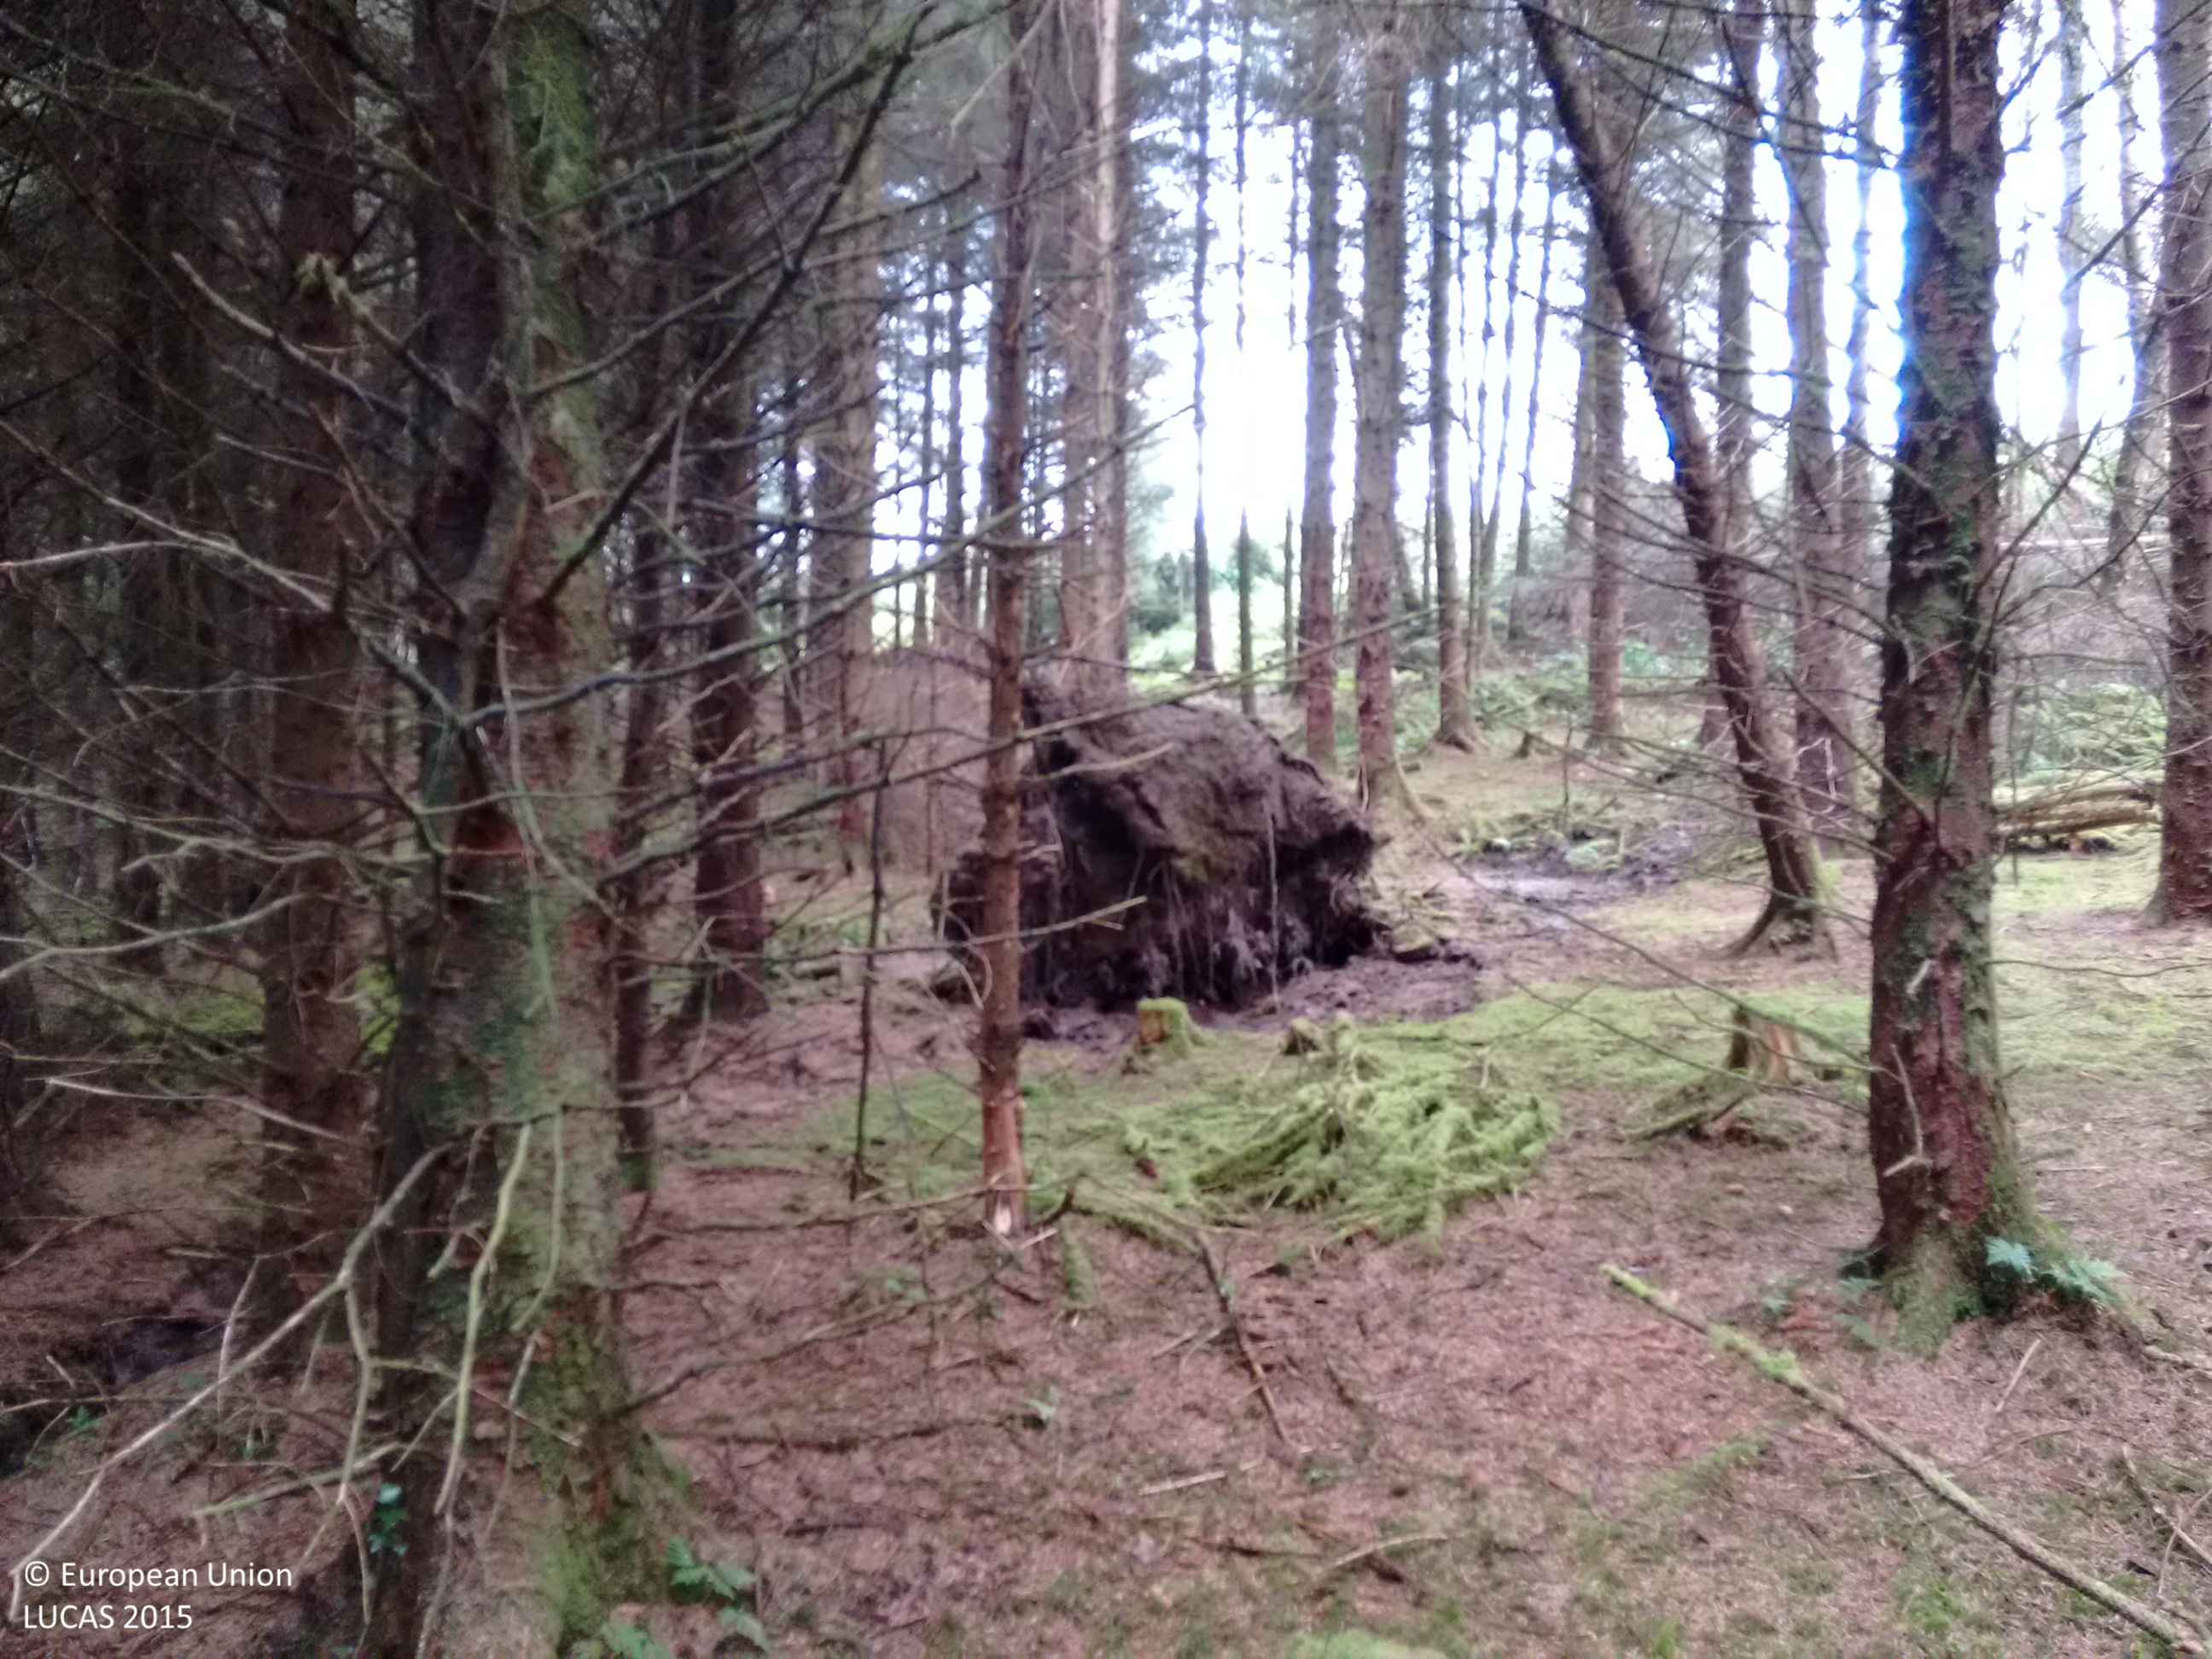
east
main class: Woodland
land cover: Spruce dominated mixed woodland
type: exotic forest
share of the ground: > 75 %
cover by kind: coniferous forest trees 75 %, broadleaved forest trees 25 %
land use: Forestry
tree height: > 5 m
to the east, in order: Spruce dominated mixed woodland; Tracks; Spontaneously vegetated surfaces; Ditches and canals; Spontaneously vegetated surfaces; Ditches and canals; Spontaneously vegetated surfaces; Rivers and streams; Spontaneously vegetated surfaces; Ditches and canals; Single bushes/trees; Ditches and canals; Spontaneously vegetated surfaces
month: July
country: IE
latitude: 52.6849
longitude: -8.3391
